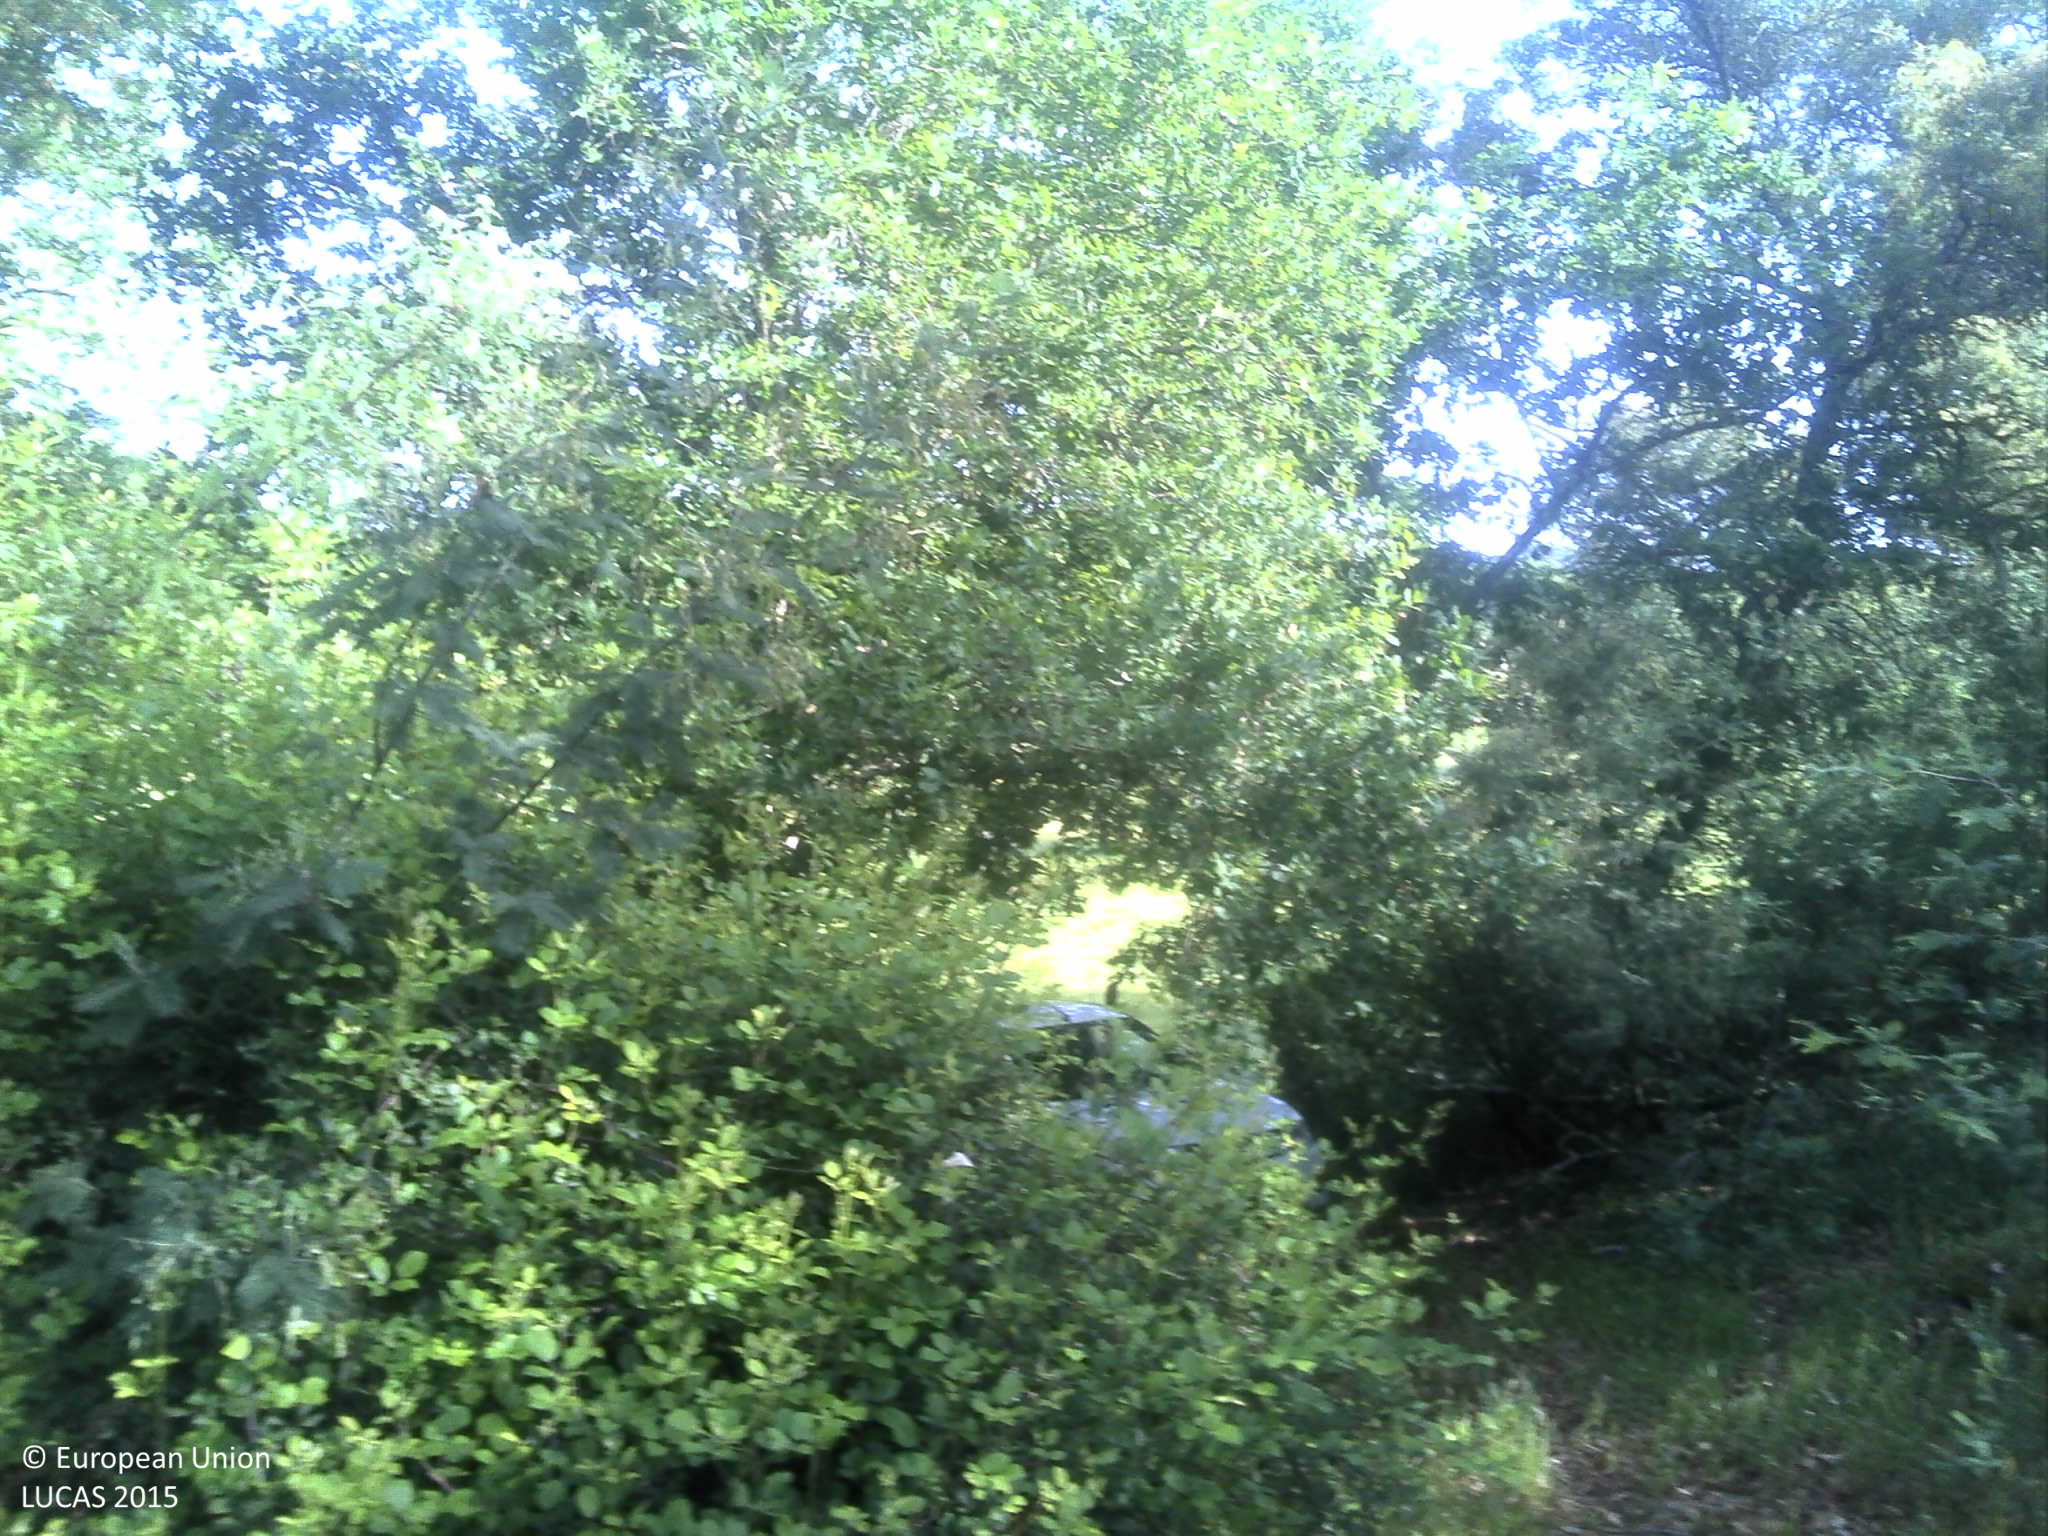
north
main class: Woodland
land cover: Broadleaved woodland
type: acidophilous oak and oak-birch forest
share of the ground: 25 - 50 %
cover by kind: broadleaved forest trees 50 %, shrubs 25 %, herbaceous plants 15 %, unconsolidated bare surface 10 %
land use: Forestry
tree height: > 5 m
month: May
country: PT
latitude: 40.6599
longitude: -7.7800
